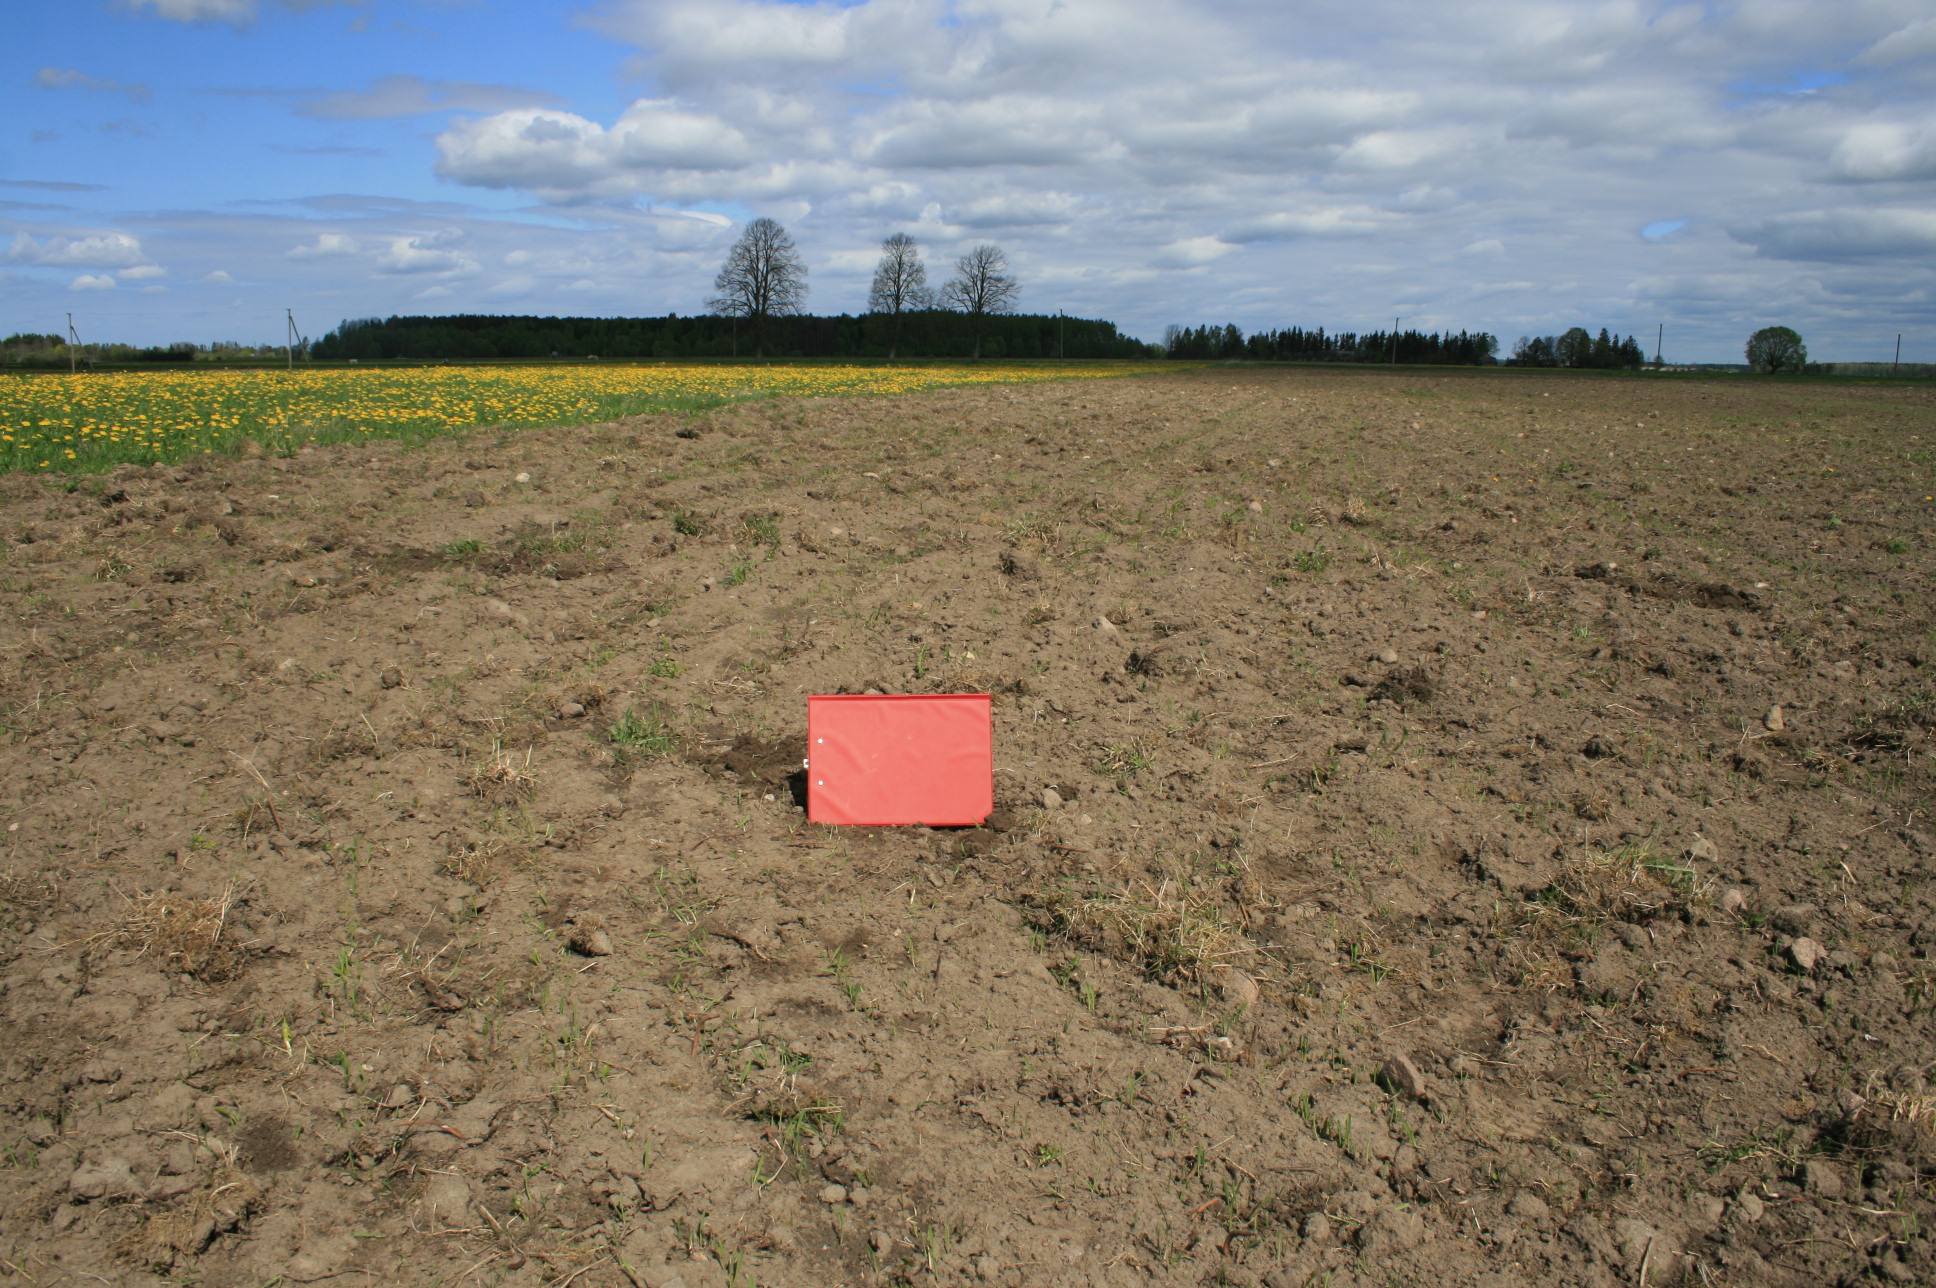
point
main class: Cropland
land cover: Oats
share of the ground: < 10 %
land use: Agriculture (excluding fallow land and kitchen gardens)
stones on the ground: < 10 %
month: May
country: LT
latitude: 56.1695
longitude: 21.5923
